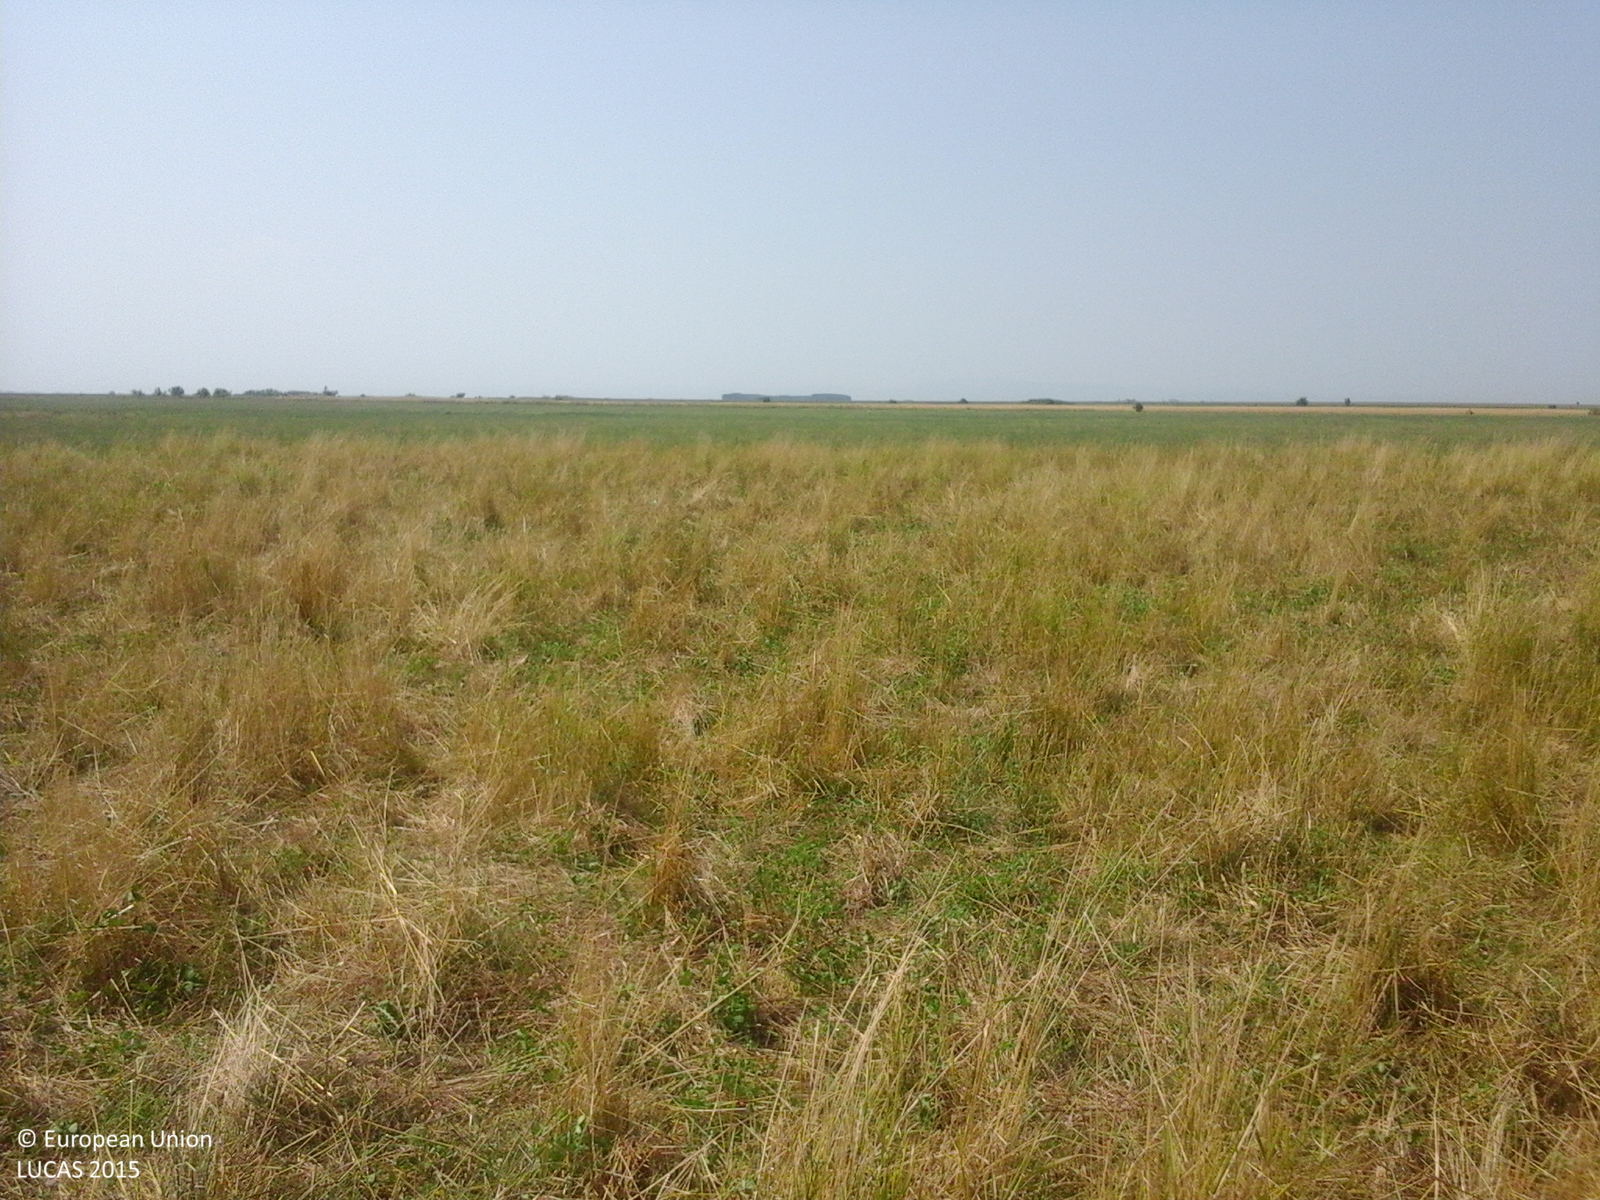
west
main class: Grassland
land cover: Grassland without tree/shrub cover
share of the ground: > 75 %
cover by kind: herbaceous plants 100 %
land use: Agriculture (excluding fallow land and kitchen gardens)
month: July
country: RO
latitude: 44.8424
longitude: 26.8144
